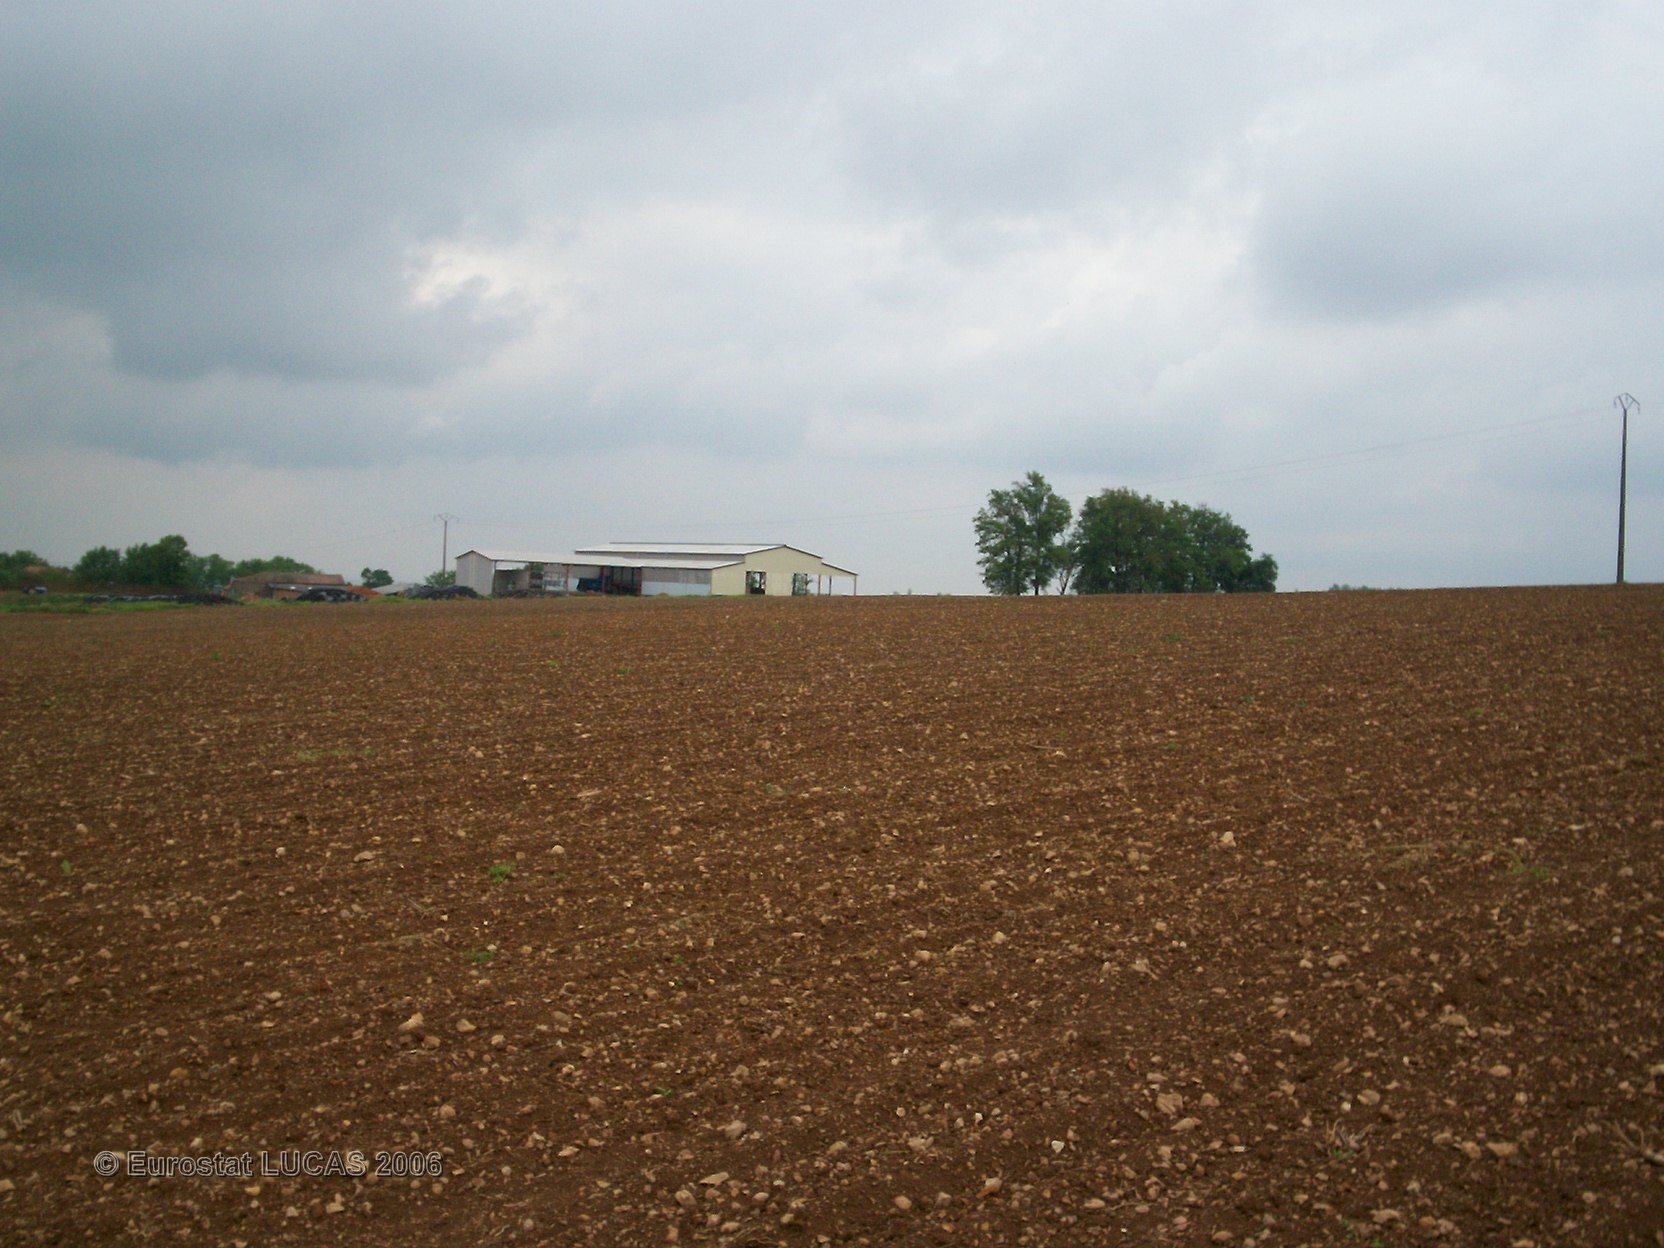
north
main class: Cropland
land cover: Maize
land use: Agriculture (excluding fallow land and kitchen gardens)
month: May
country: FR
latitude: 45.7272
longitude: 0.4902
